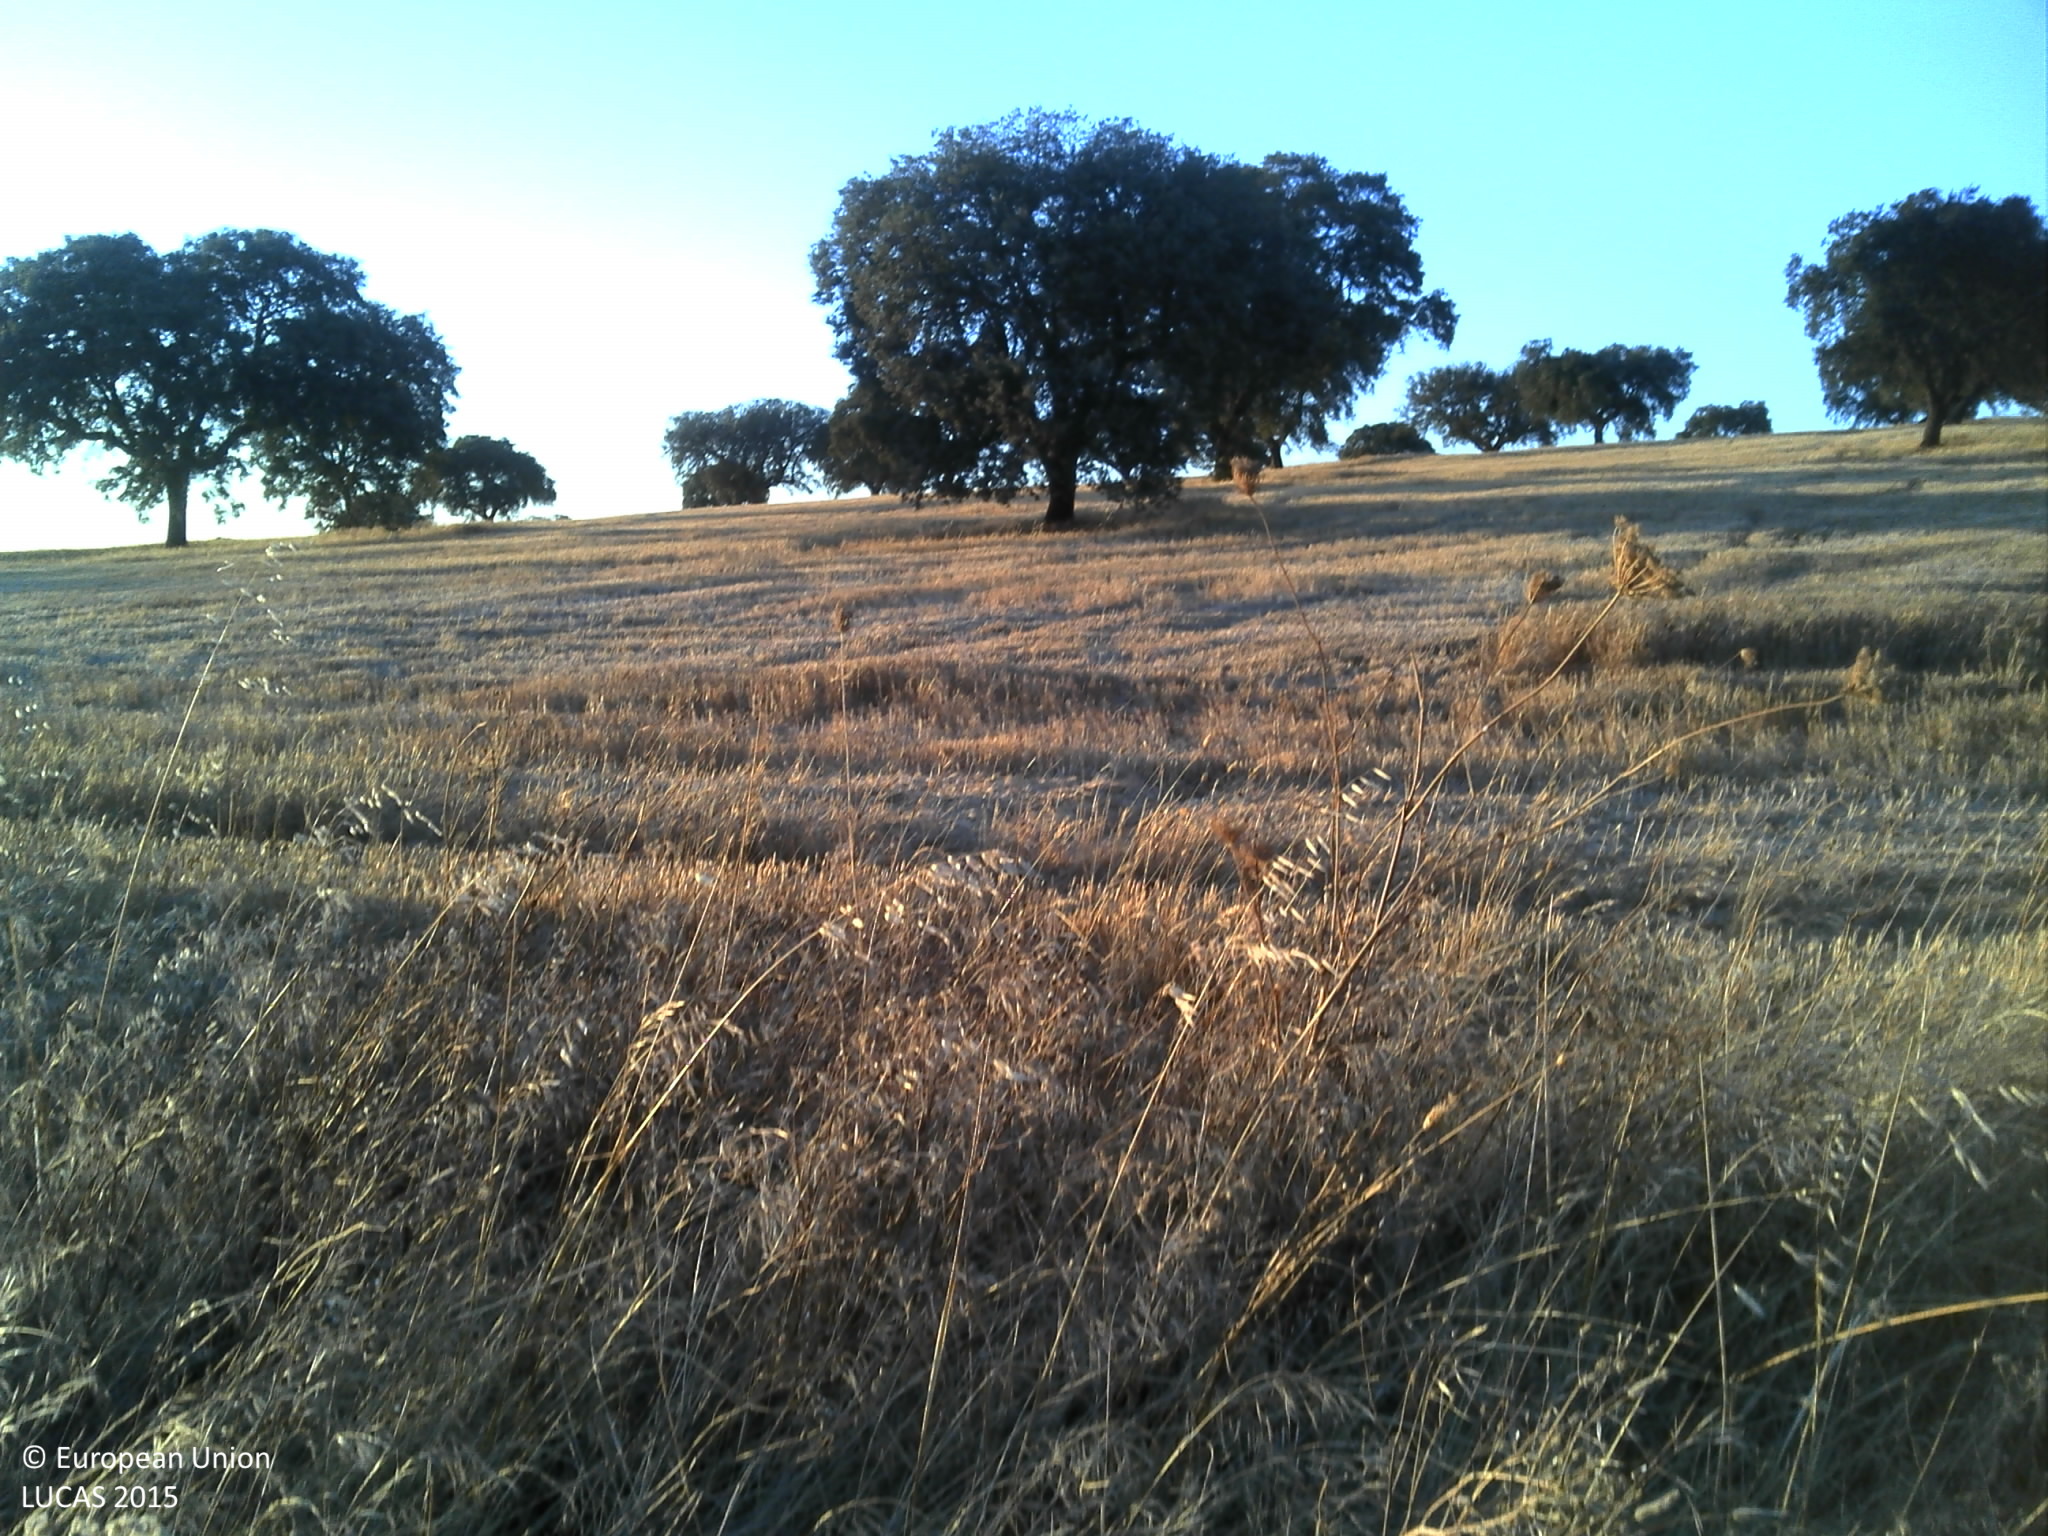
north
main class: Grassland
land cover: Grassland without tree/shrub cover
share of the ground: > 75 %
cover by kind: herbaceous plants 100 %
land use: Agriculture (excluding fallow land and kitchen gardens)
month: July
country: PT
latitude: 37.8440
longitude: -8.0169
